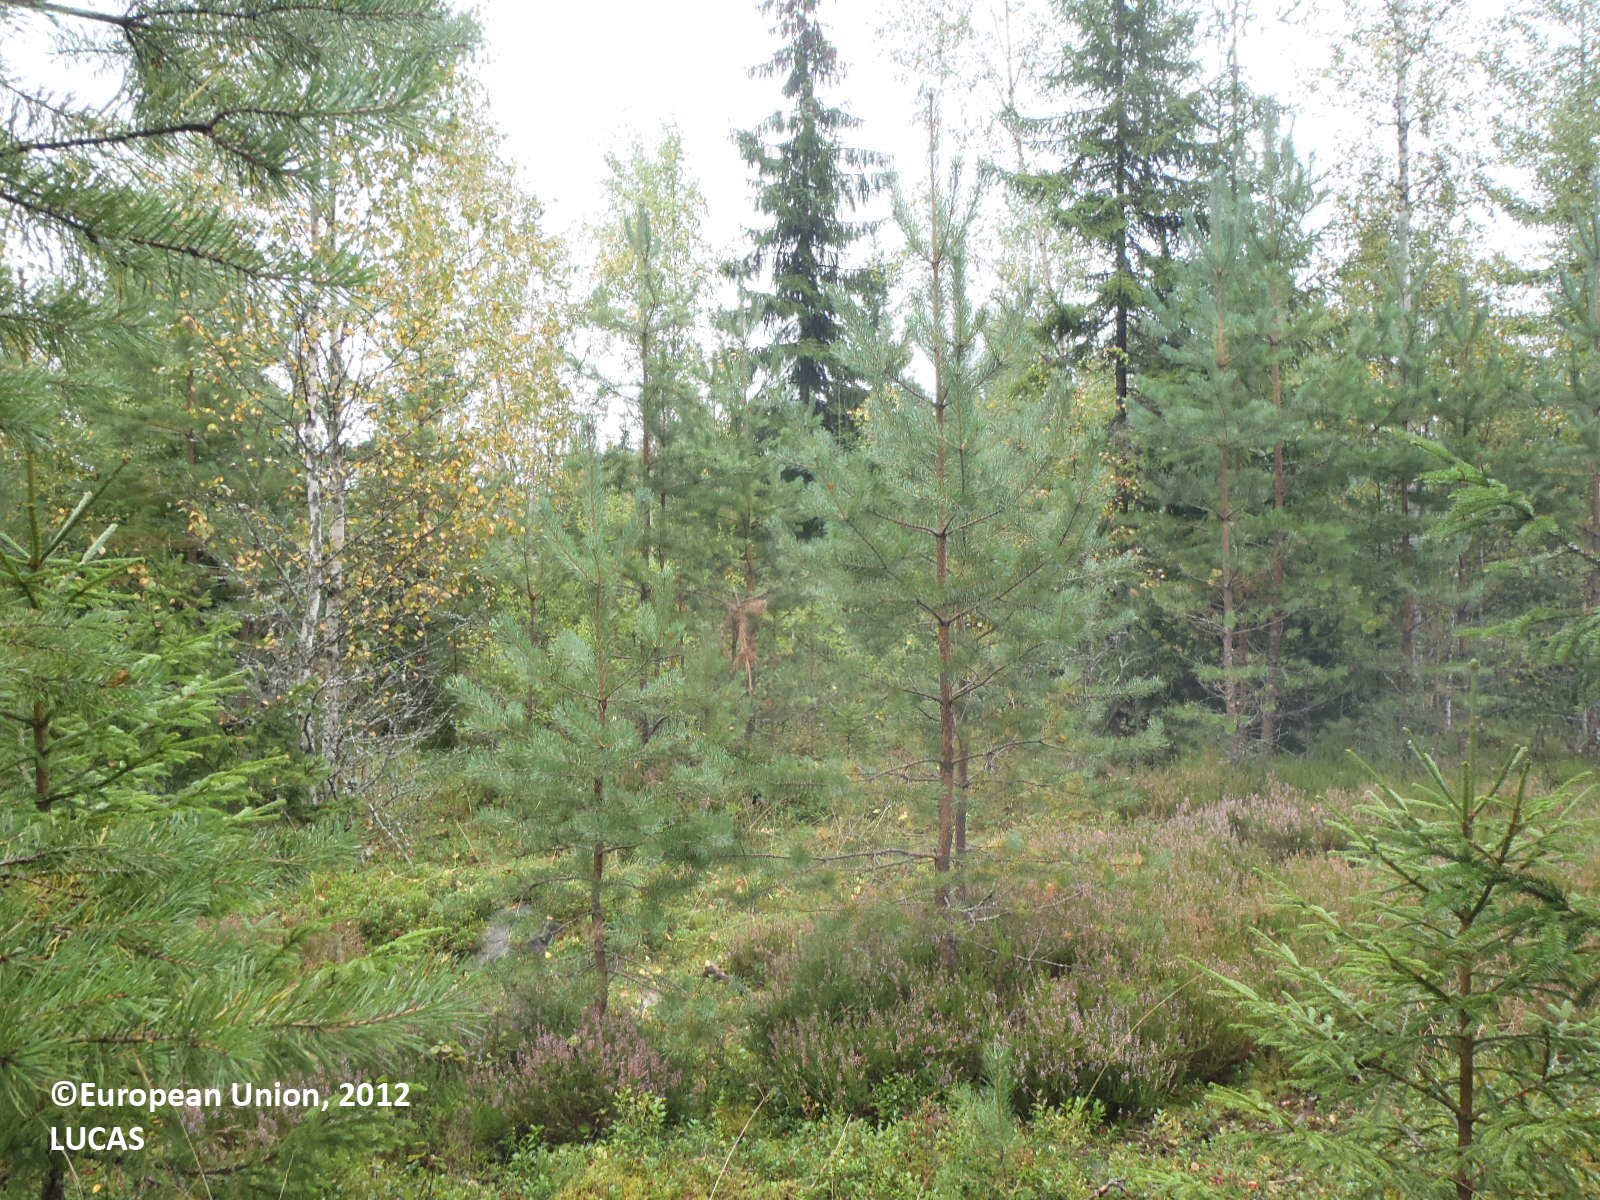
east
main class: Woodland
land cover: Other mixed woodland
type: boreal forest
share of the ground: 50 - 75 %
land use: Forestry
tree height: > 5 m
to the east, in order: Other mixed woodland; Pine dominated mixed woodland
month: September
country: FI
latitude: 60.7327
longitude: 22.7433
